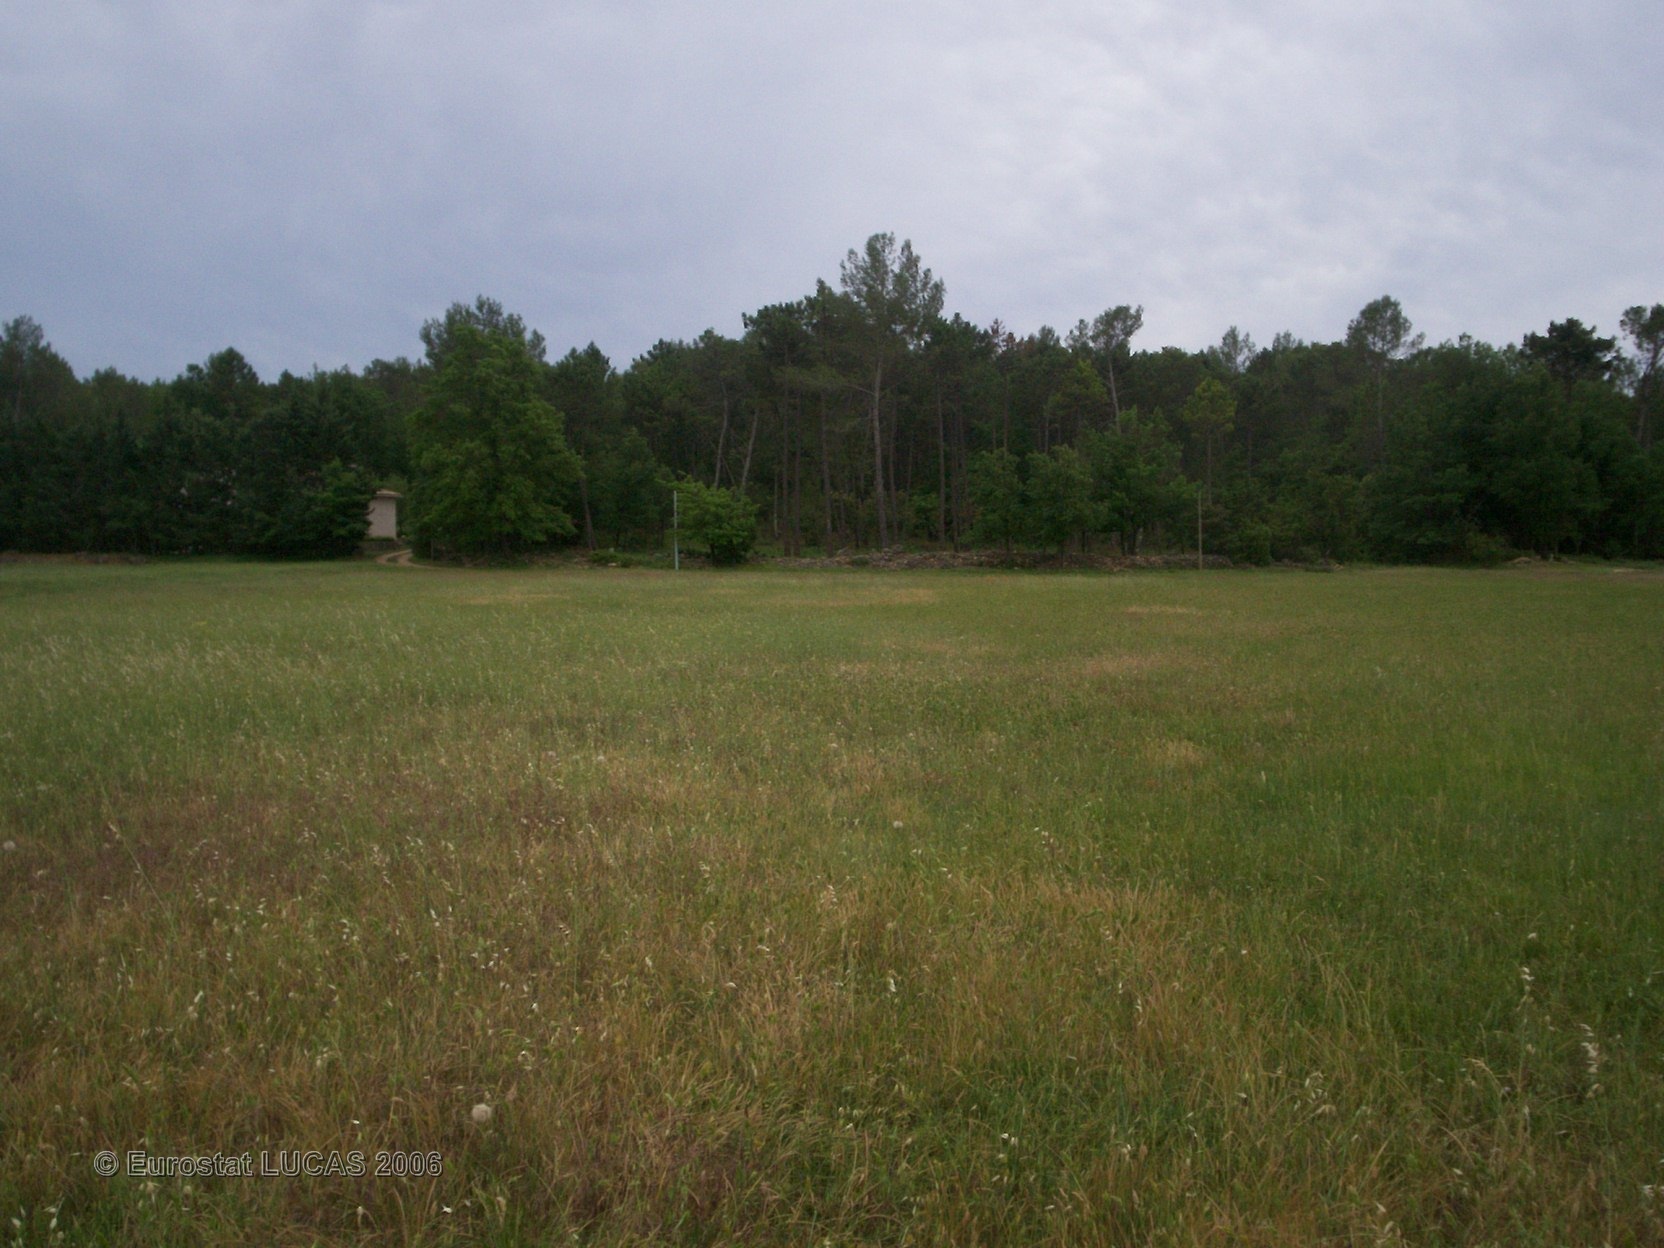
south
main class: Grassland
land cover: Grassland without tree/shrub cover
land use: Agriculture (excluding fallow land and kitchen gardens)
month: May
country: FR
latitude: 43.5711
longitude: 6.5537
